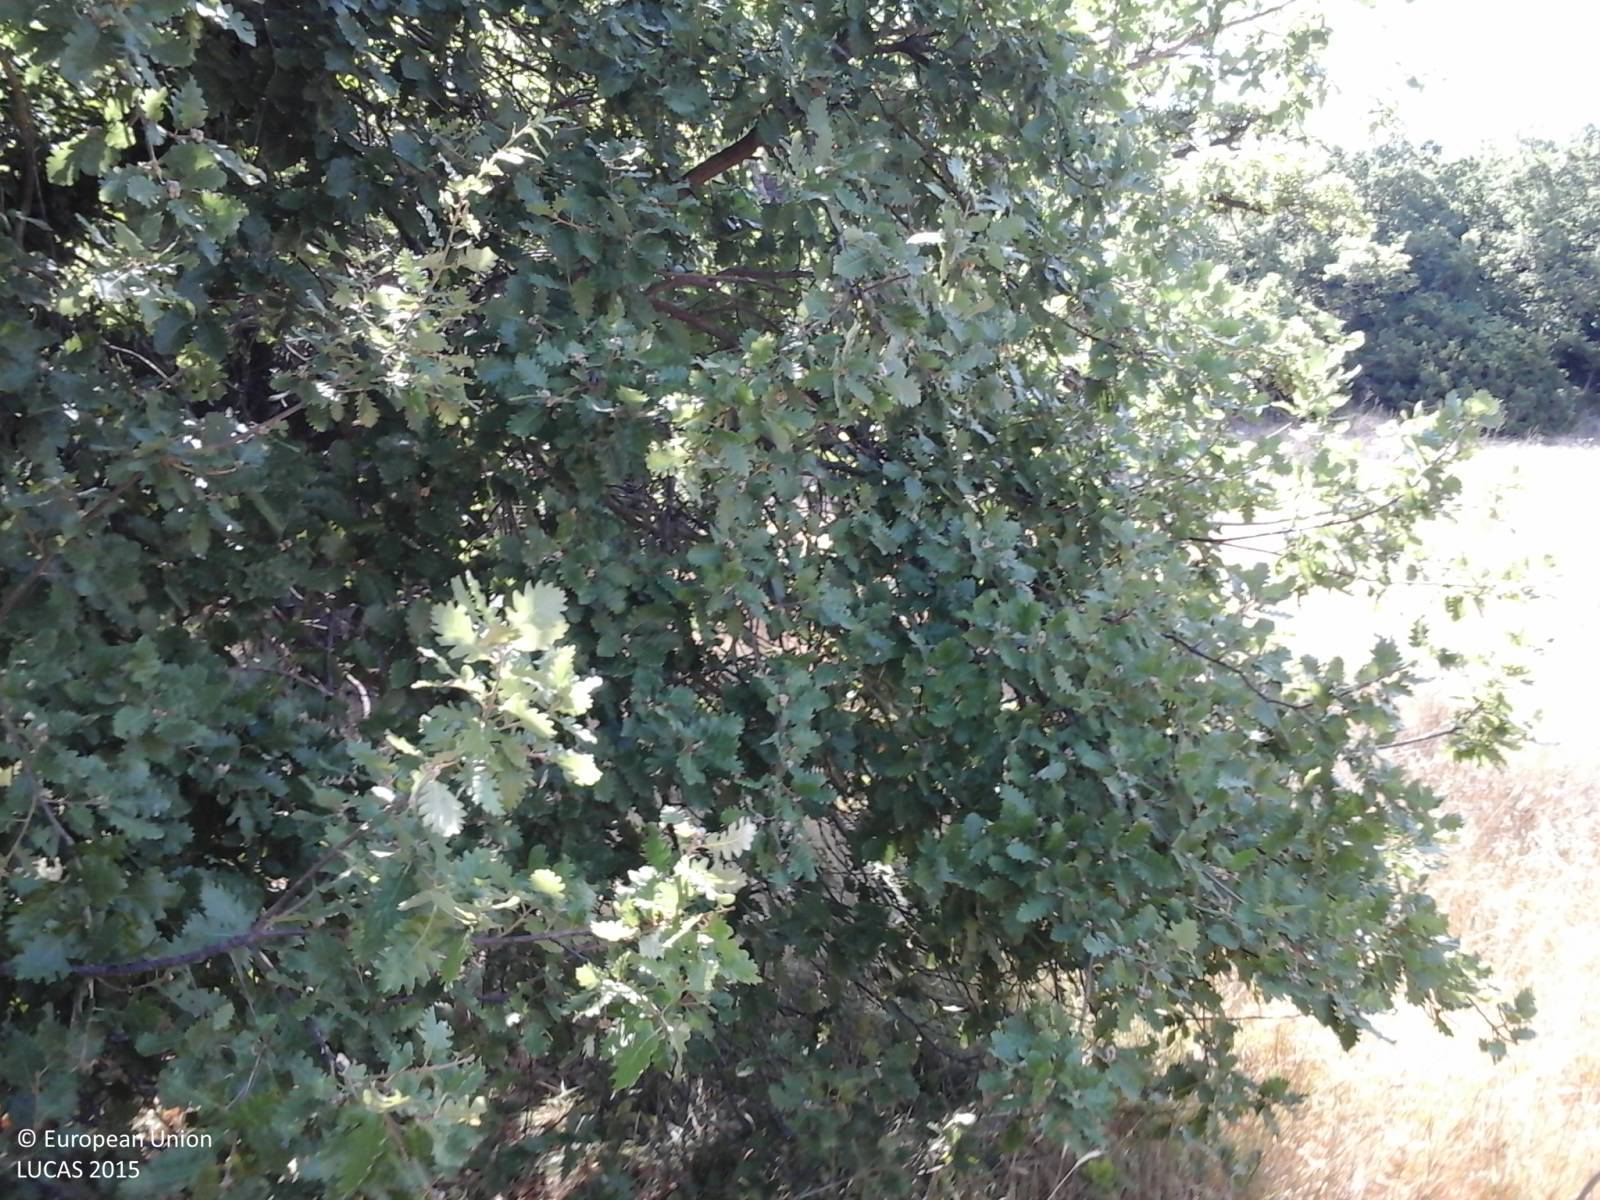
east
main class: Woodland
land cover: Broadleaved woodland
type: thermophilous deciduous forest
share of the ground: 25 - 50 %
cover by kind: broadleaved forest trees 90 %, herbaceous plants 10 %
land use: Semi-natural and natural areas not in use
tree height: > 5 m
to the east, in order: Broadleaved woodland; Fences; Broadleaved woodland; Grassland without tree/shrub cover; Fences; Grassland without tree/shrub cover; Fences; Grass margins; Tracks; Grassland without tree/shrub cover; Fences; Dry stone walls; Grassland without tree/shrub cover; Single bushes/trees; Grassland with sparse tree/shrub cover; Dry stone walls; Fences; Other fresh vegetables; Fences; Dry stone walls; Tracks; Fences; Grassland with sparse tree/shrub cover
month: July
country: IT
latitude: 40.7850
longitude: 8.8088
